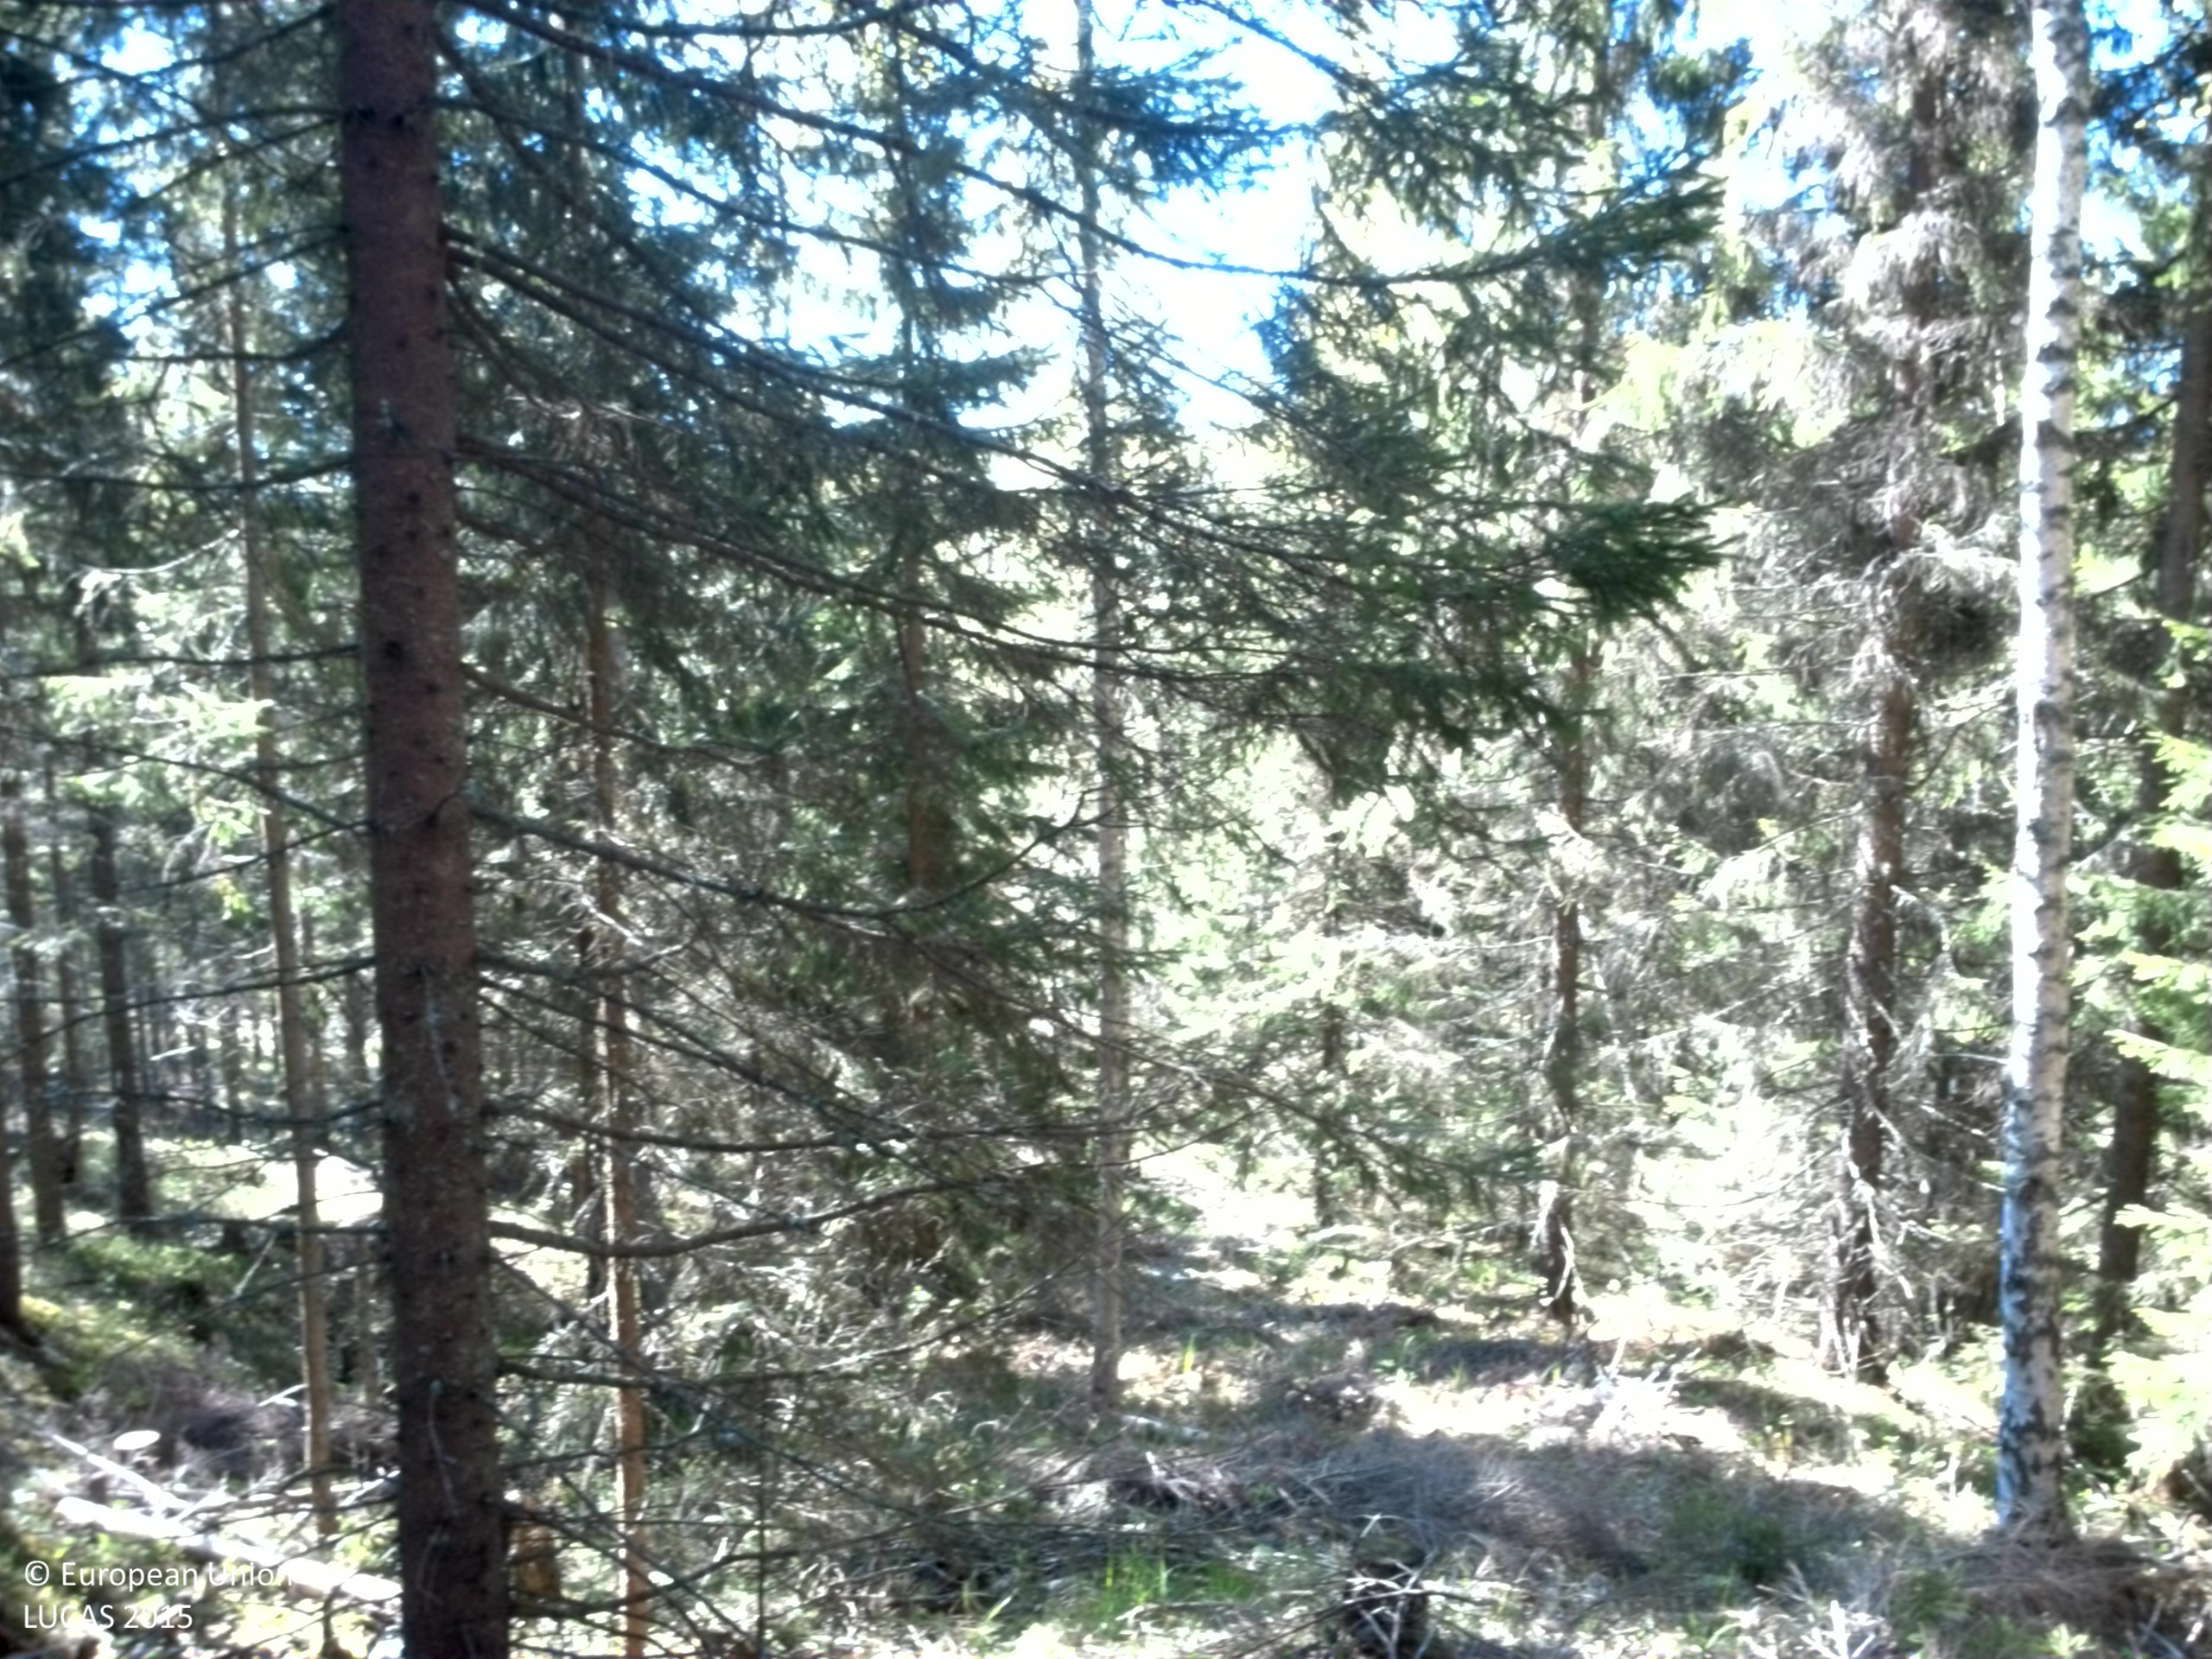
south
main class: Woodland
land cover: Spruce dominated coniferous woodland
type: boreal forest
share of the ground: 25 - 50 %
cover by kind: coniferous forest trees 50 %, shrubs 20 %, lichens and mosses 10 %
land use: Forestry
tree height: > 5 m
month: May
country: SE
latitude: 63.0015
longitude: 17.9351
